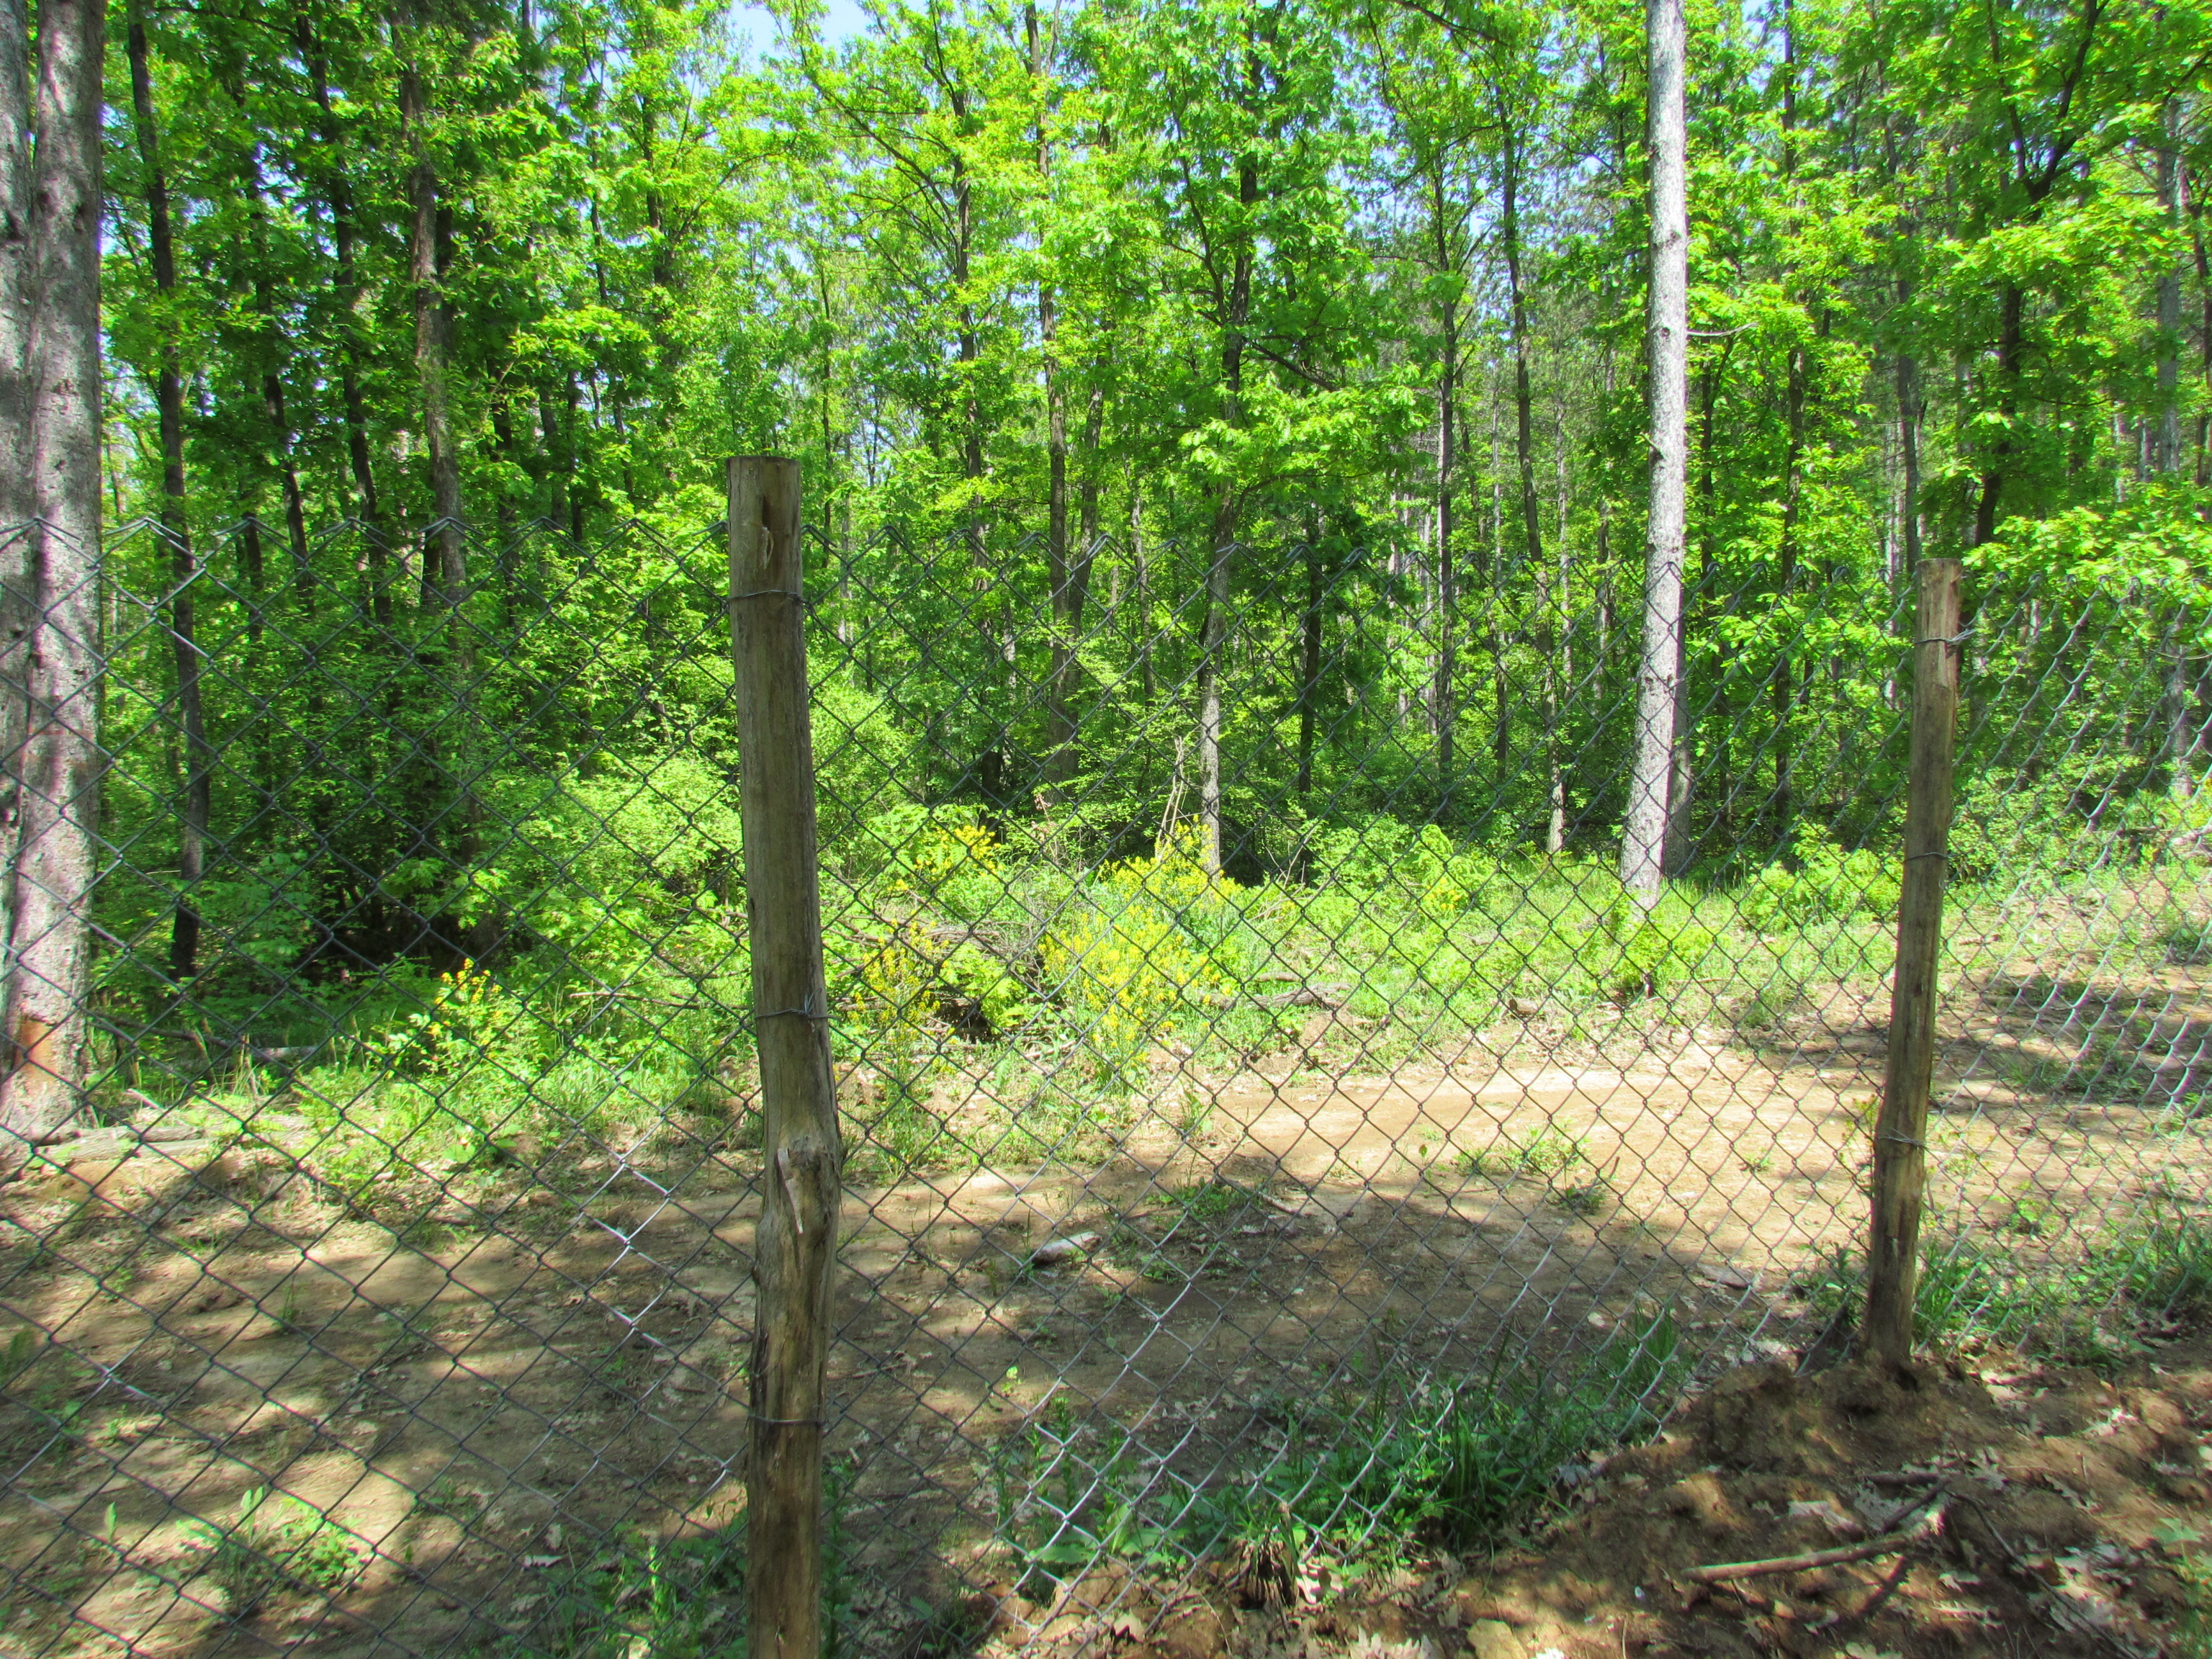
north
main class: Woodland
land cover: Pine dominated mixed woodland
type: hemiboreal forest and nemoral coniferous forest and mixed broadleaved-coniferous forest
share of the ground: > 75 %
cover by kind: broadleaved forest trees 75 %, coniferous forest trees 25 %
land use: Forestry
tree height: > 5 m
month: May
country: BG
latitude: 42.2321
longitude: 27.1286
